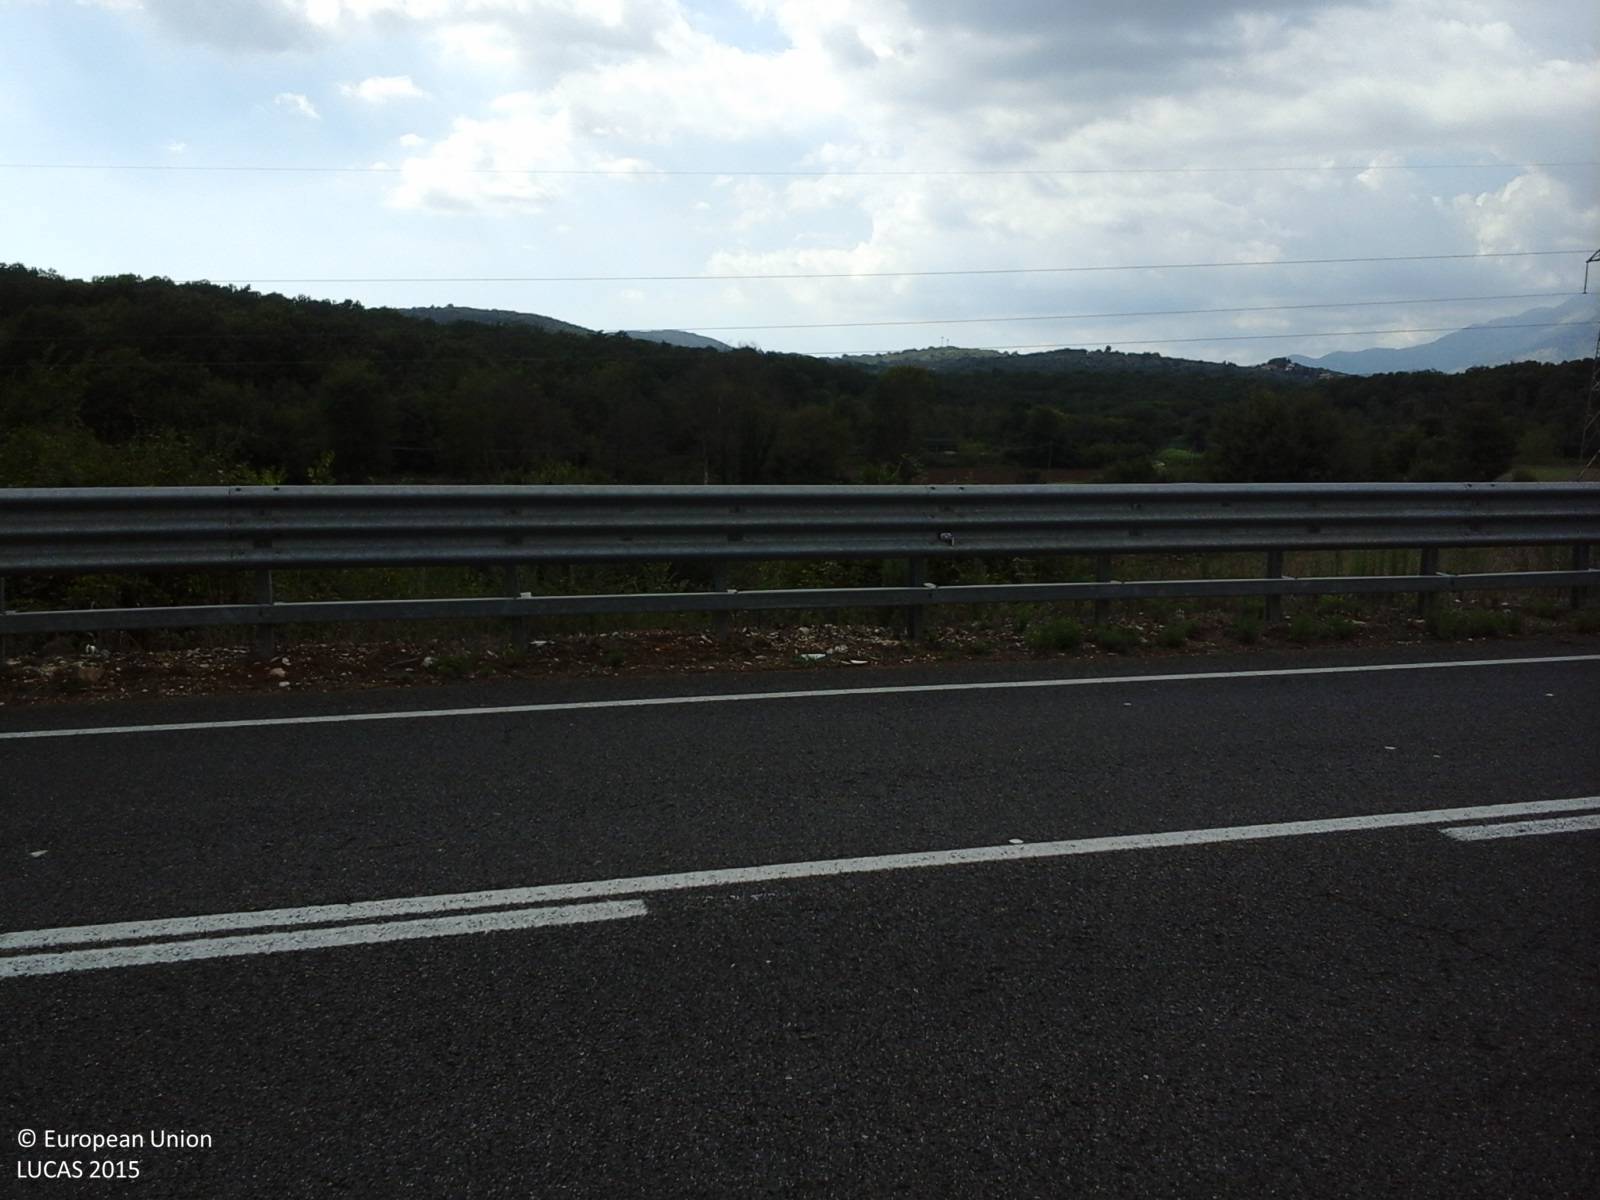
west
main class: Grassland
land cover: Grassland with sparse tree/shrub cover
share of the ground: > 75 %
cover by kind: herbaceous plants 85 %, shrubs 10 %, broadleaved forest trees 5 %
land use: Abandoned areas
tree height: < 5 m
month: August
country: IT
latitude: 41.4460
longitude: 13.2071
